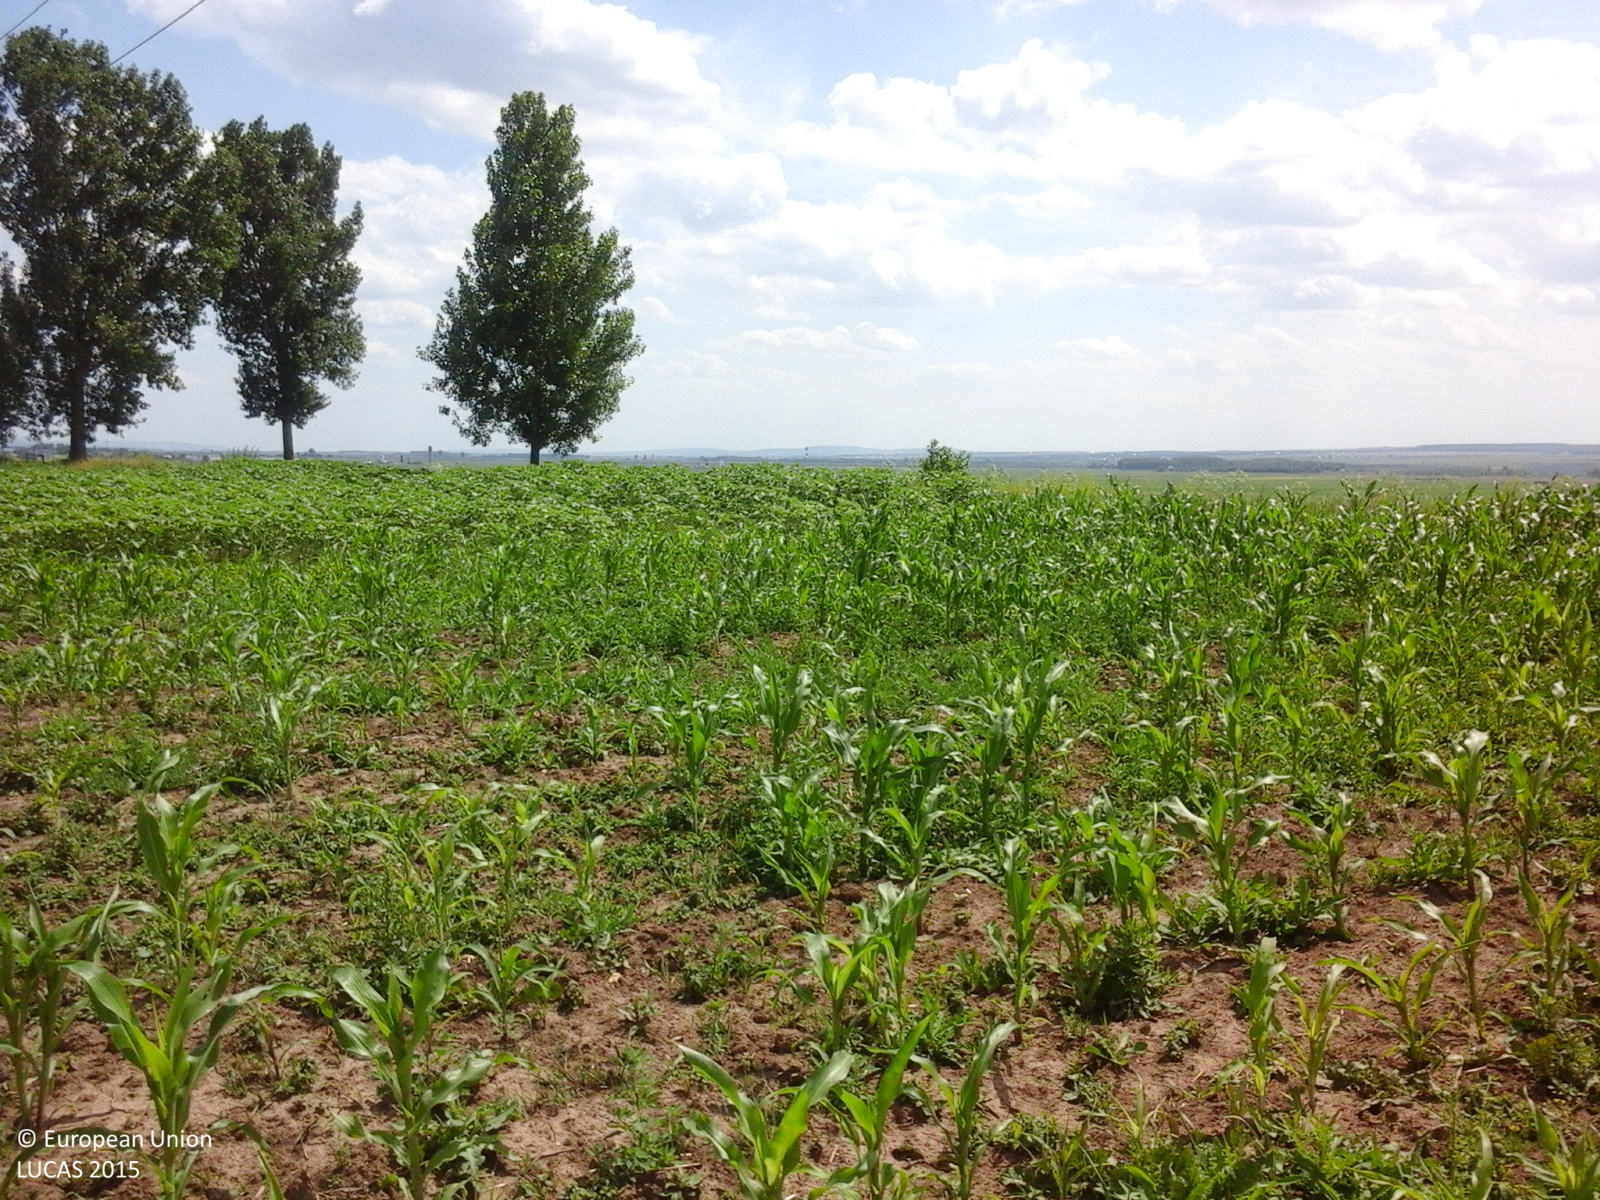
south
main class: Cropland
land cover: Maize
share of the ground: > 75 %
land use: Agriculture (excluding fallow land and kitchen gardens)
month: June
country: RO
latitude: 47.7899
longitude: 26.4138
